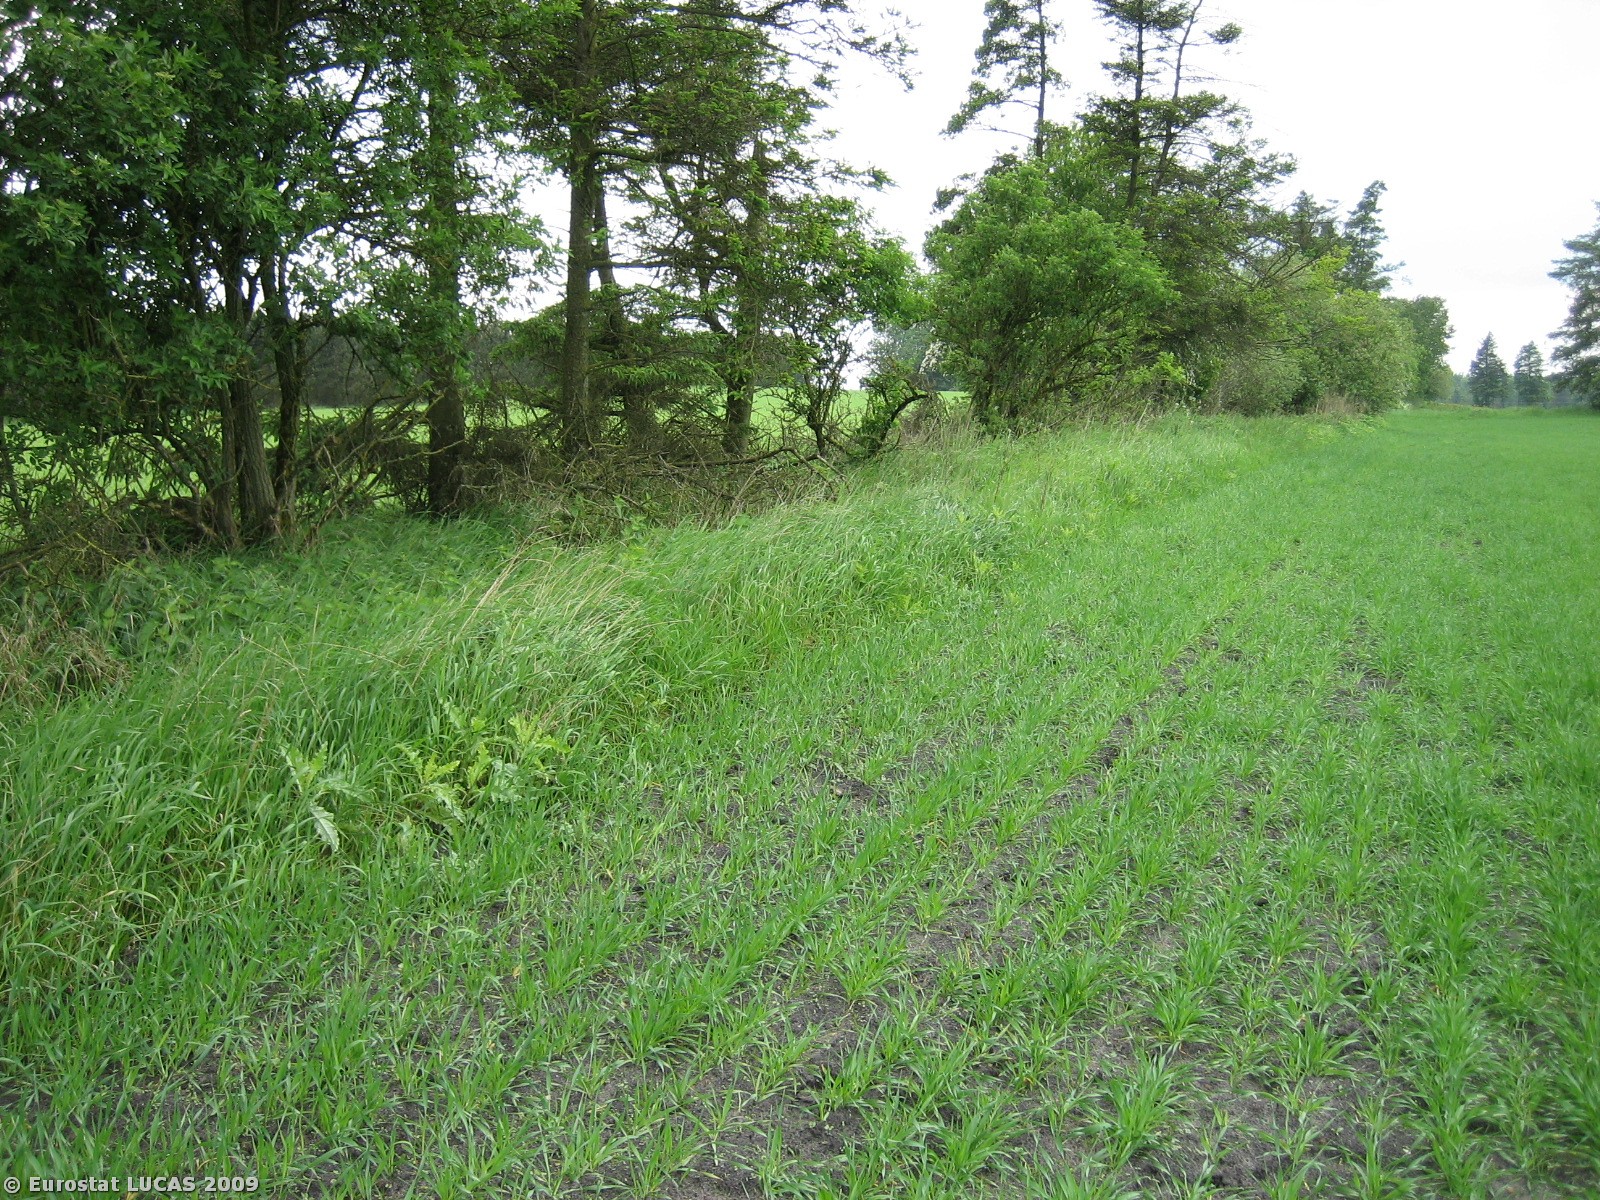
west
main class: Cropland
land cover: Barley
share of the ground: 50 - 75 %
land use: Agriculture (excluding fallow land and kitchen gardens)
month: May
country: DK
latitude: 55.7903
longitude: 9.2831
